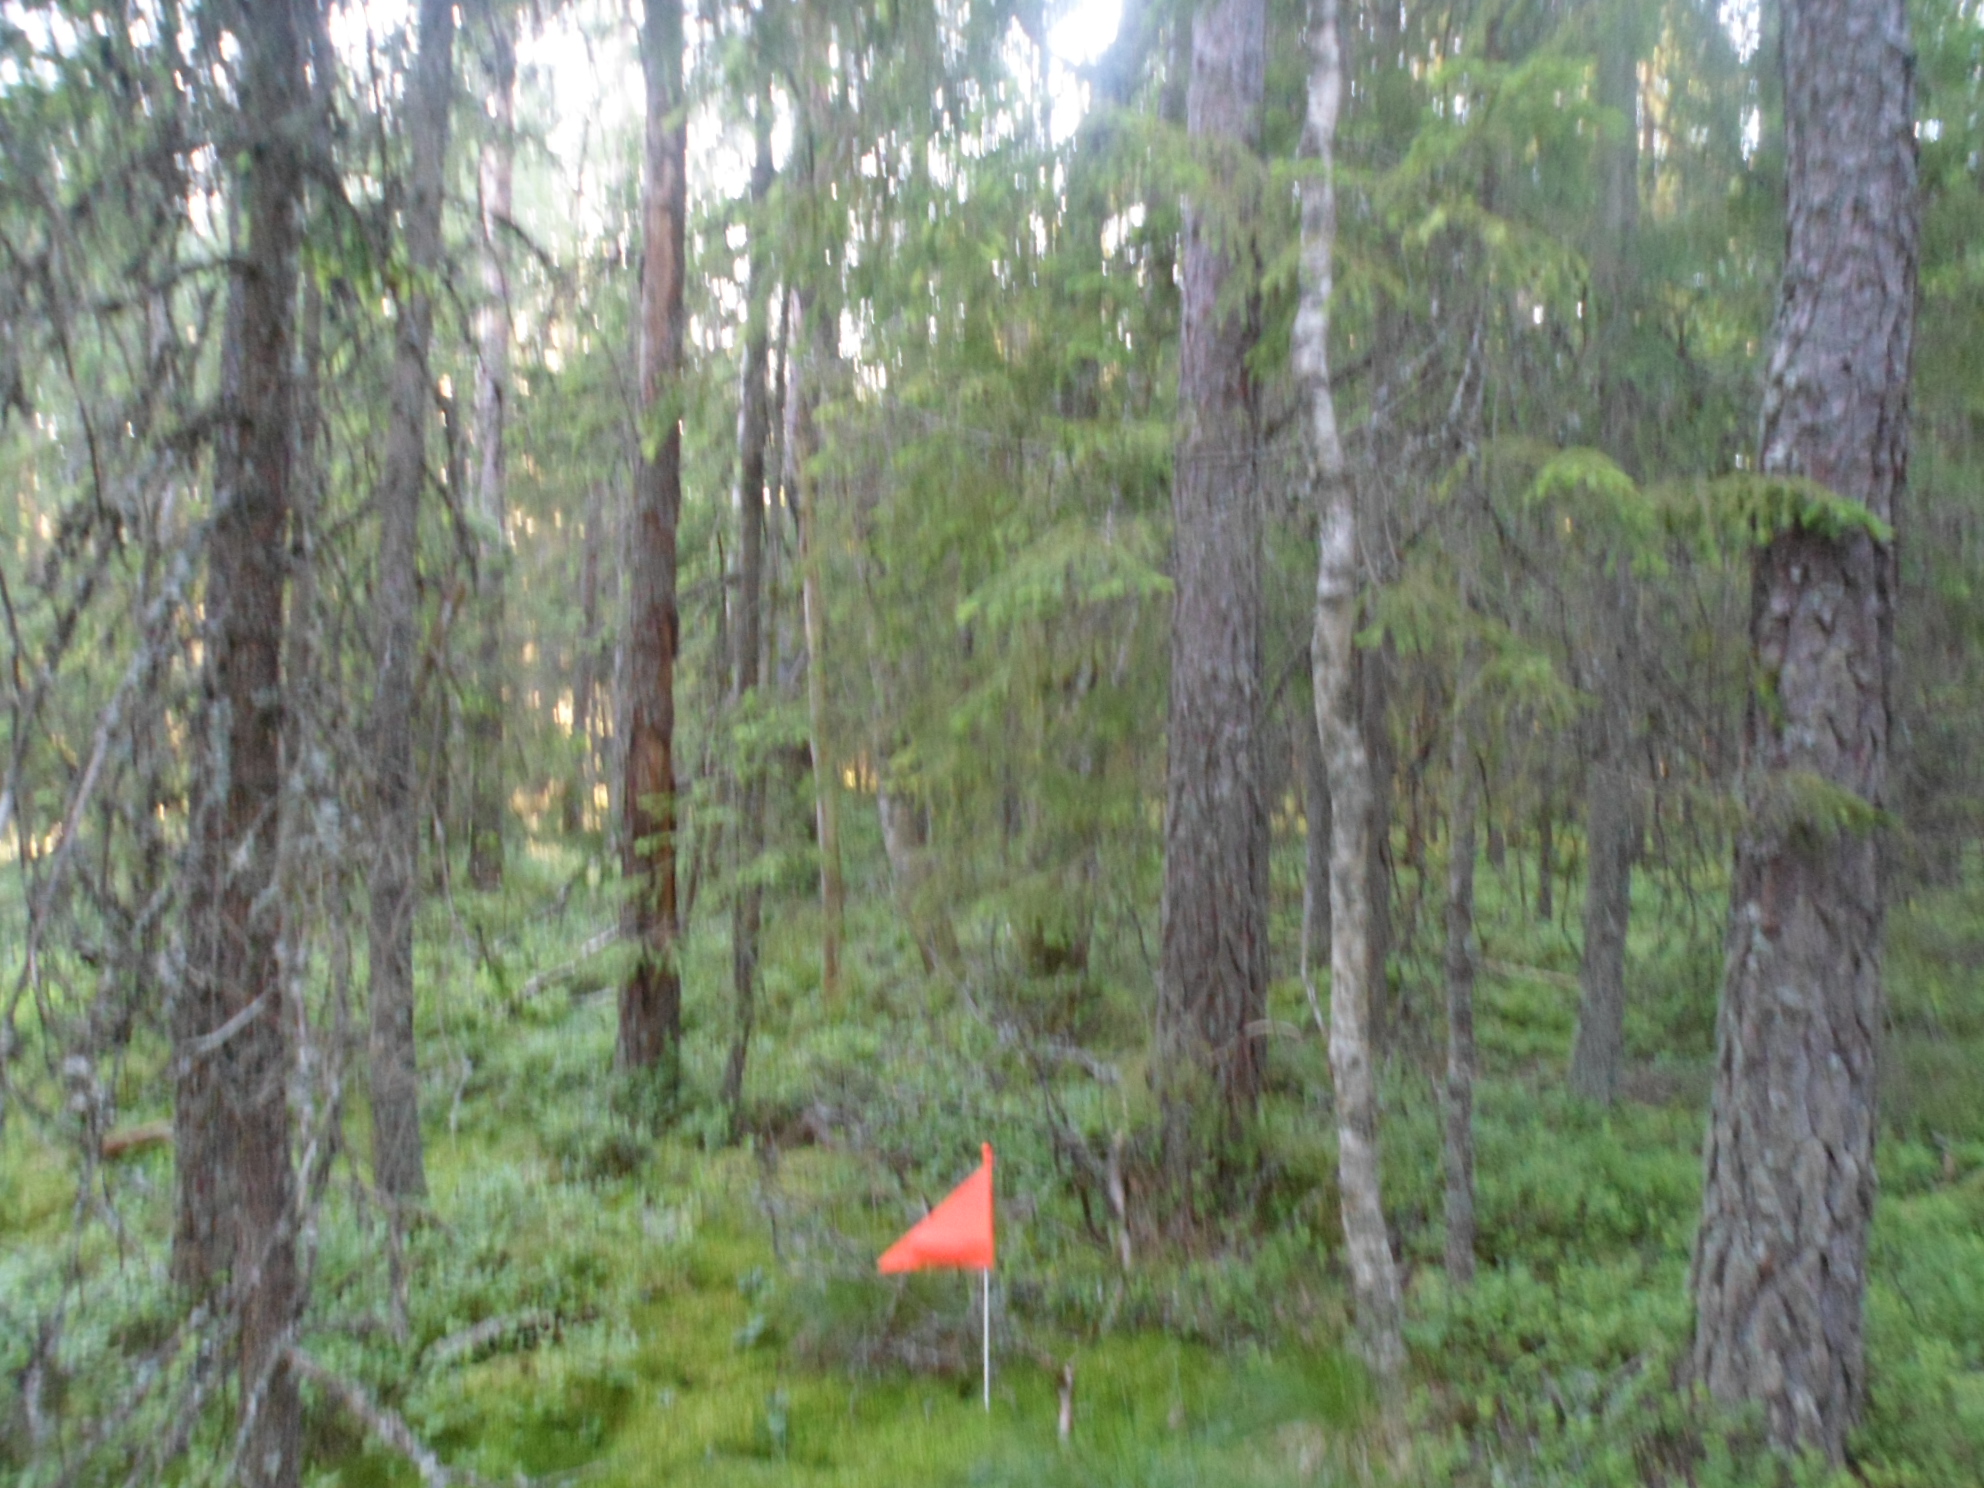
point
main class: Woodland
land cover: Pine dominated coniferous woodland
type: boreal forest
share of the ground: 50 - 75 %
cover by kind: coniferous forest trees 50 %, lichens and mosses 25 %, broadleaved forest trees 10 %, shrubs 10 %, herbaceous plants 5 %
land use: Forestry
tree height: > 5 m
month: July
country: SE
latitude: 57.5164
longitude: 14.4197
